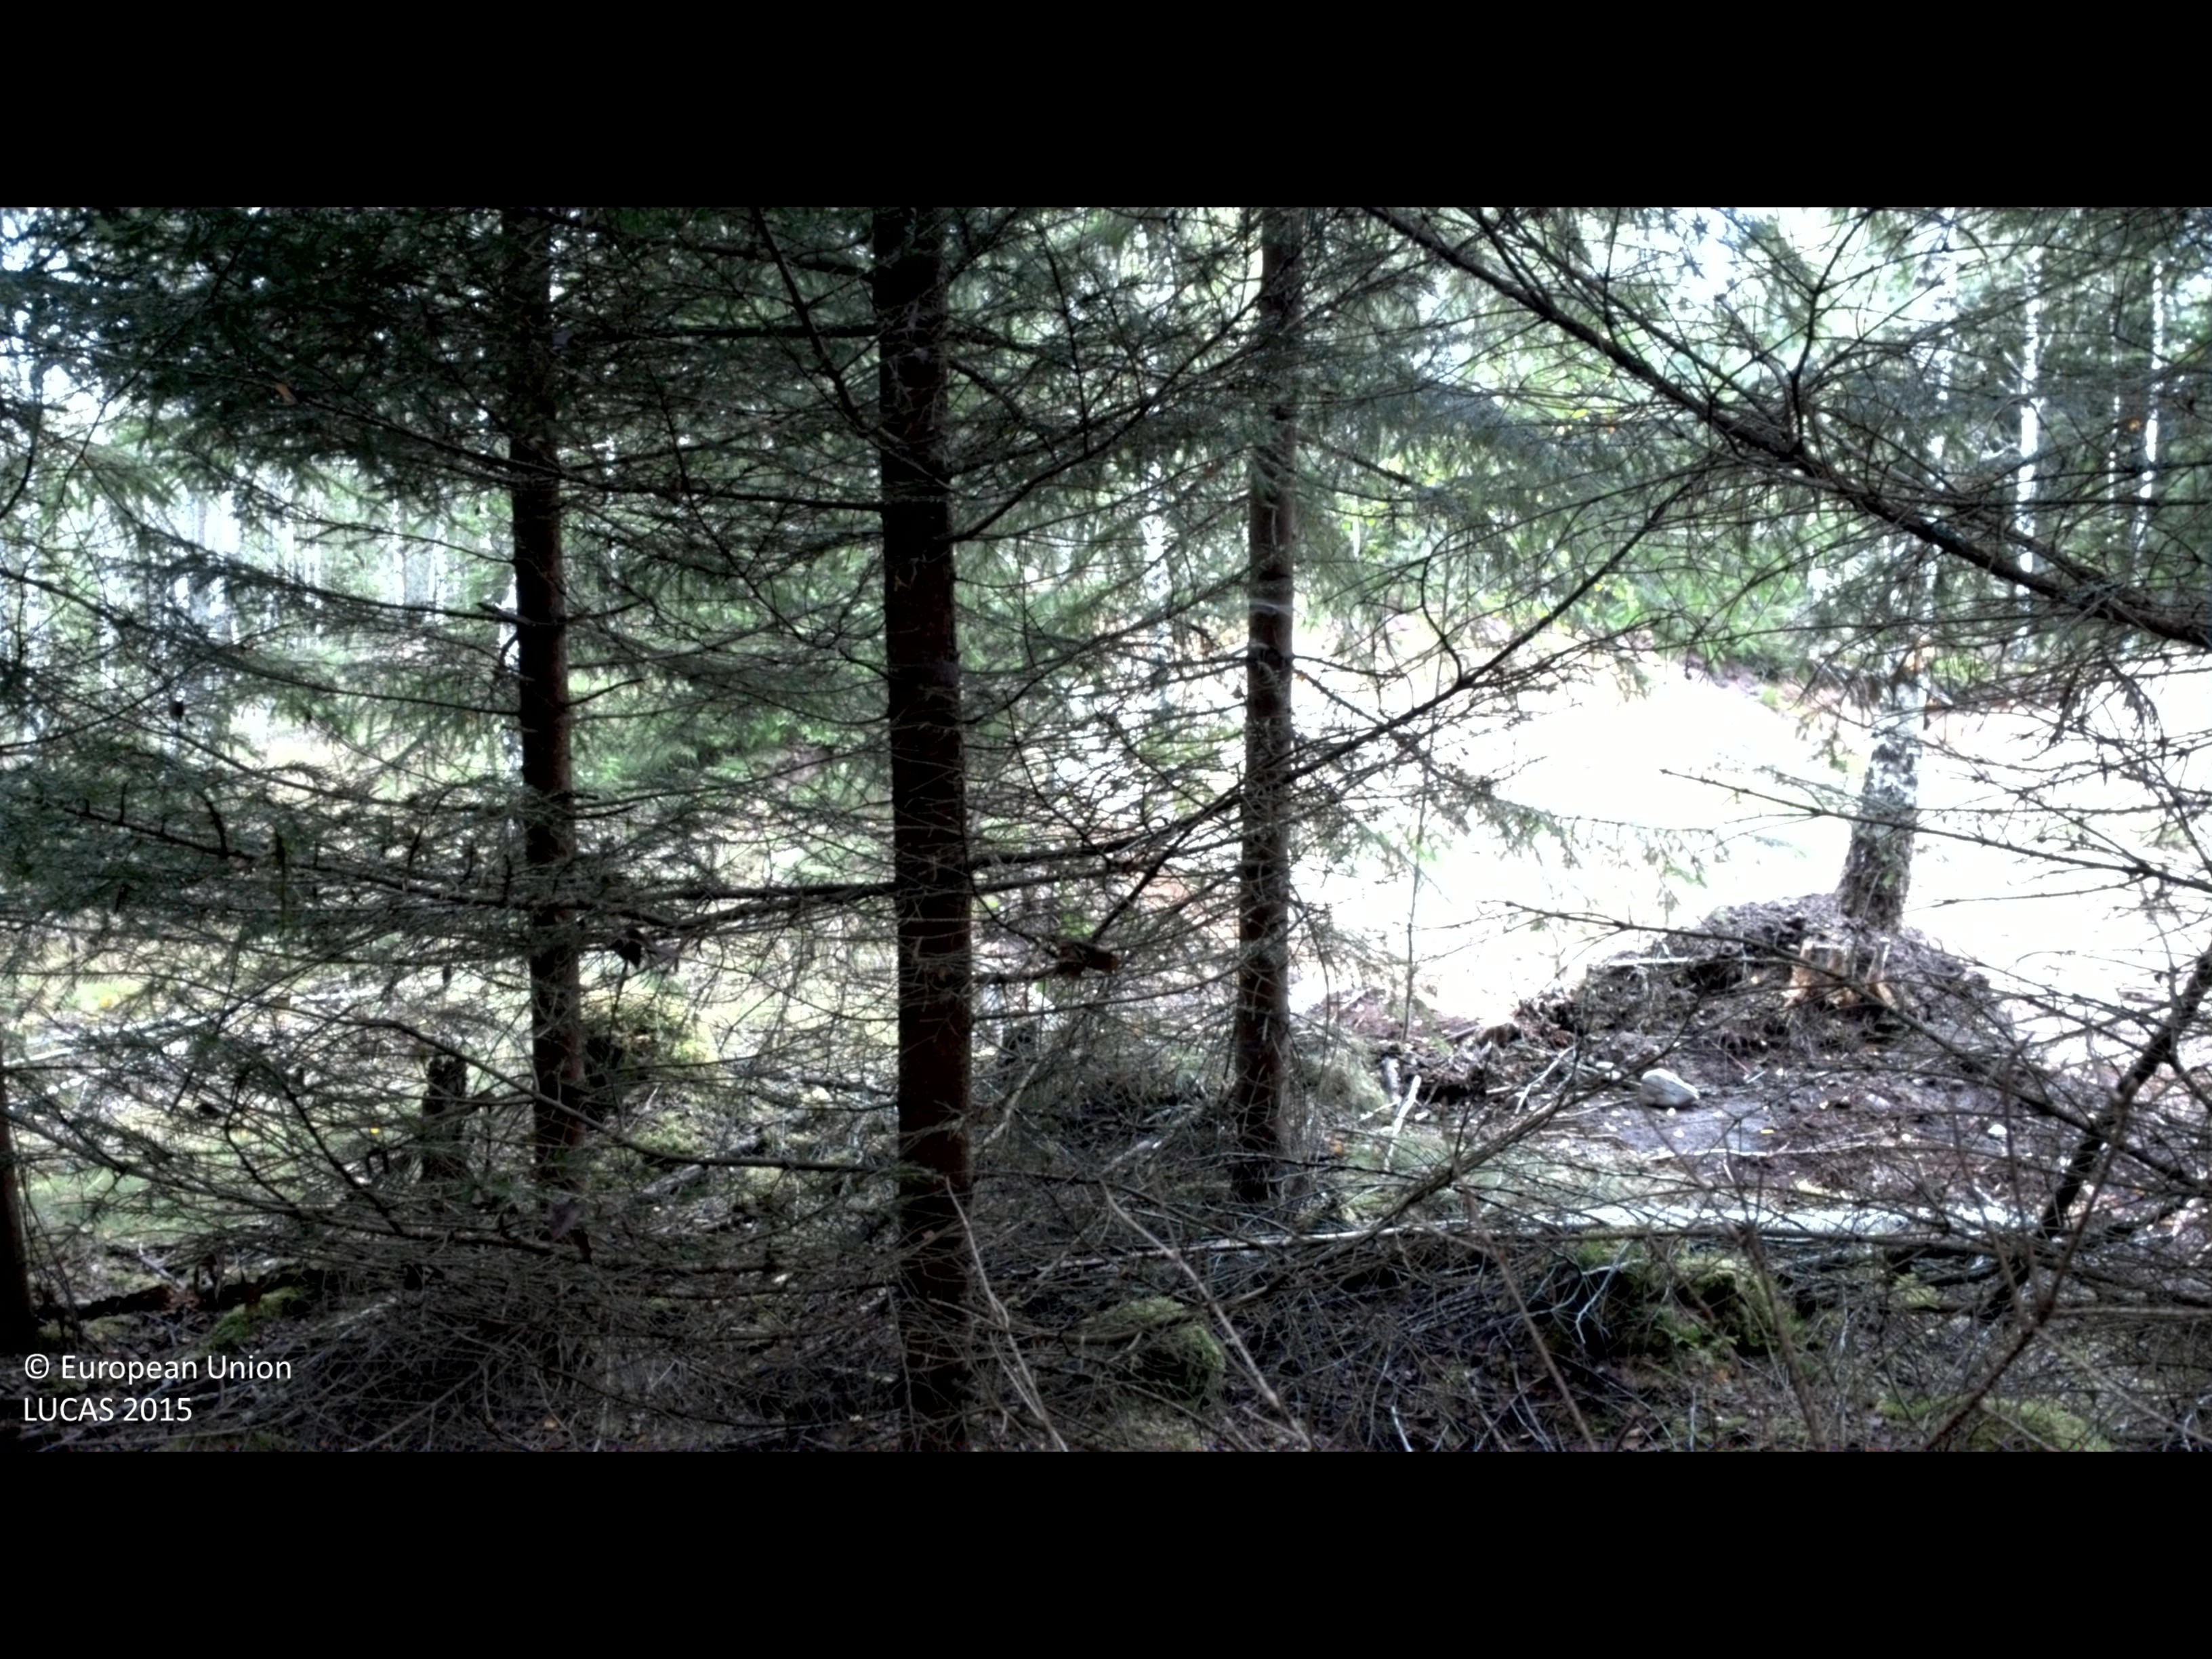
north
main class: Woodland
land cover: Spruce dominated coniferous woodland
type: boreal forest
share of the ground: > 75 %
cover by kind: coniferous forest trees 60 %, broadleaved forest trees 15 %, lichens and mosses 15 %, shrubs 10 %
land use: Forestry
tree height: > 5 m
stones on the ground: 25 - 50 %
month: July
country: SE
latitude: 56.8501
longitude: 13.8498
